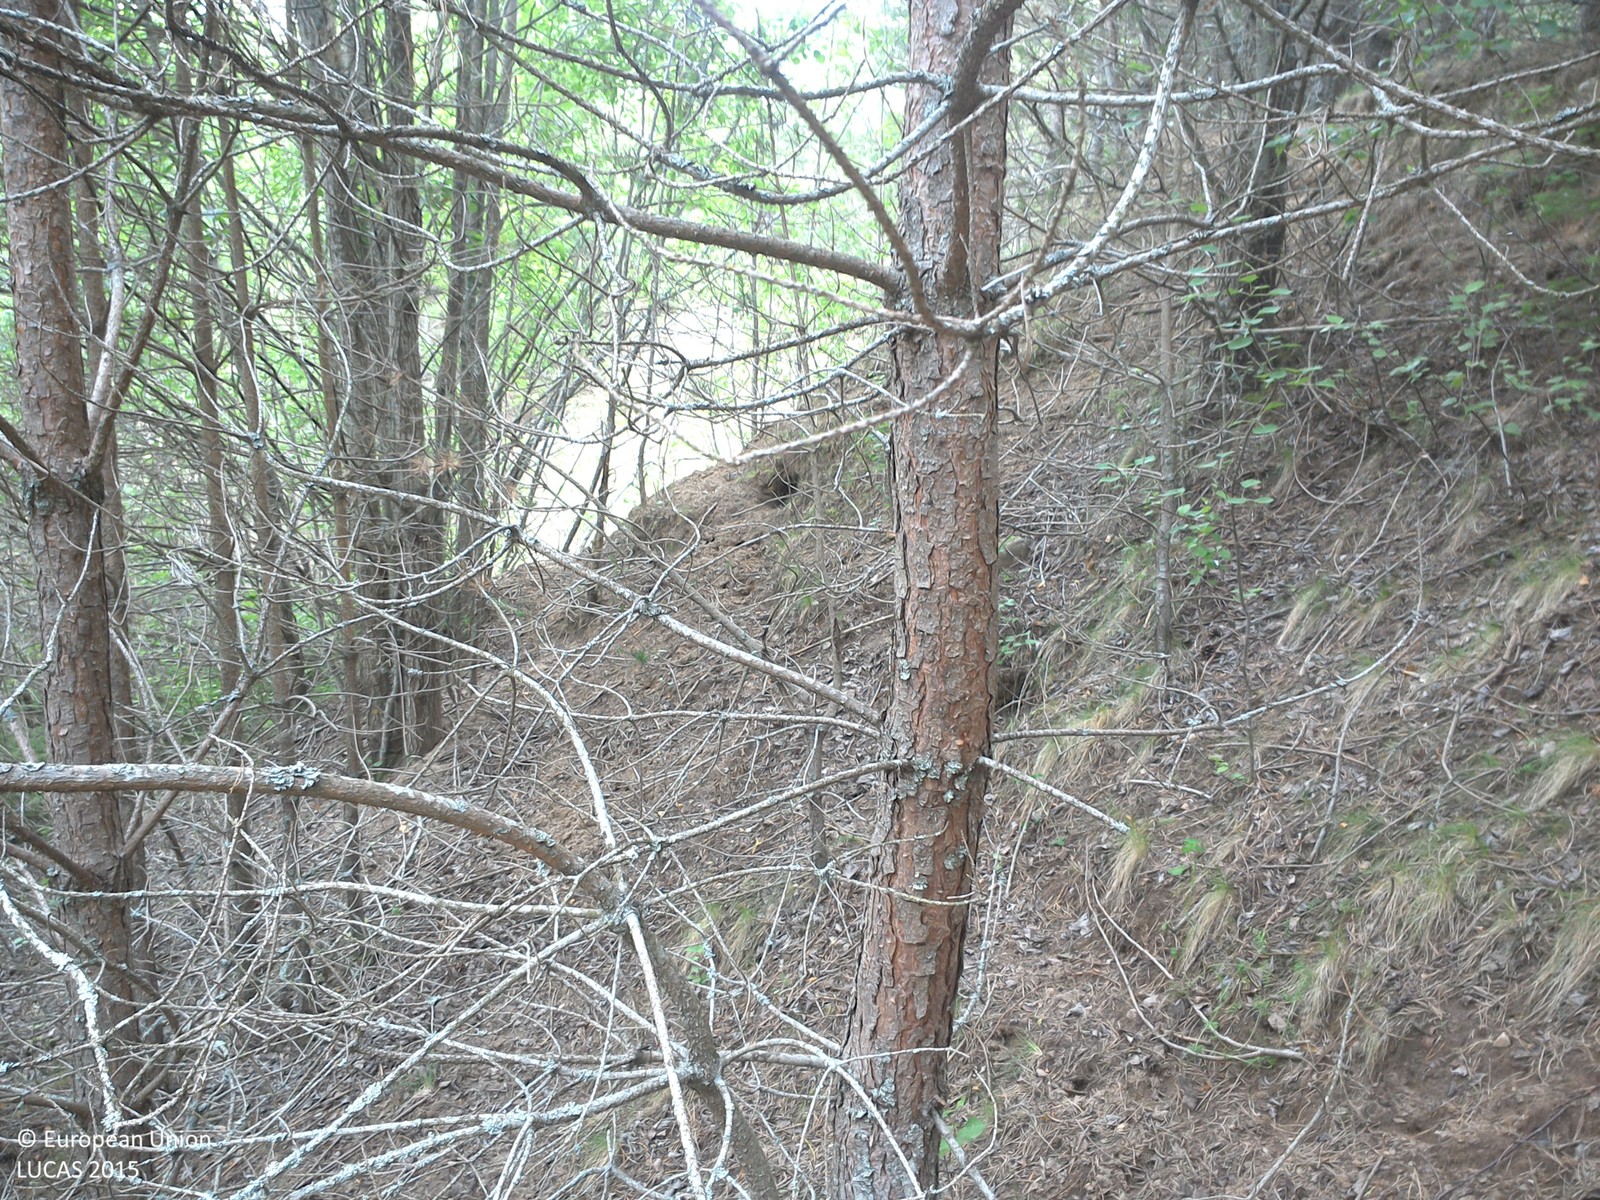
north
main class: Woodland
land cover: Pine dominated coniferous woodland
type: boreal forest
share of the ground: > 75 %
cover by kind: coniferous forest trees 85 %, unconsolidated bare surface 15 %
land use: Forestry
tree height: > 5 m
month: June
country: SE
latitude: 58.3754
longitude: 15.5517
